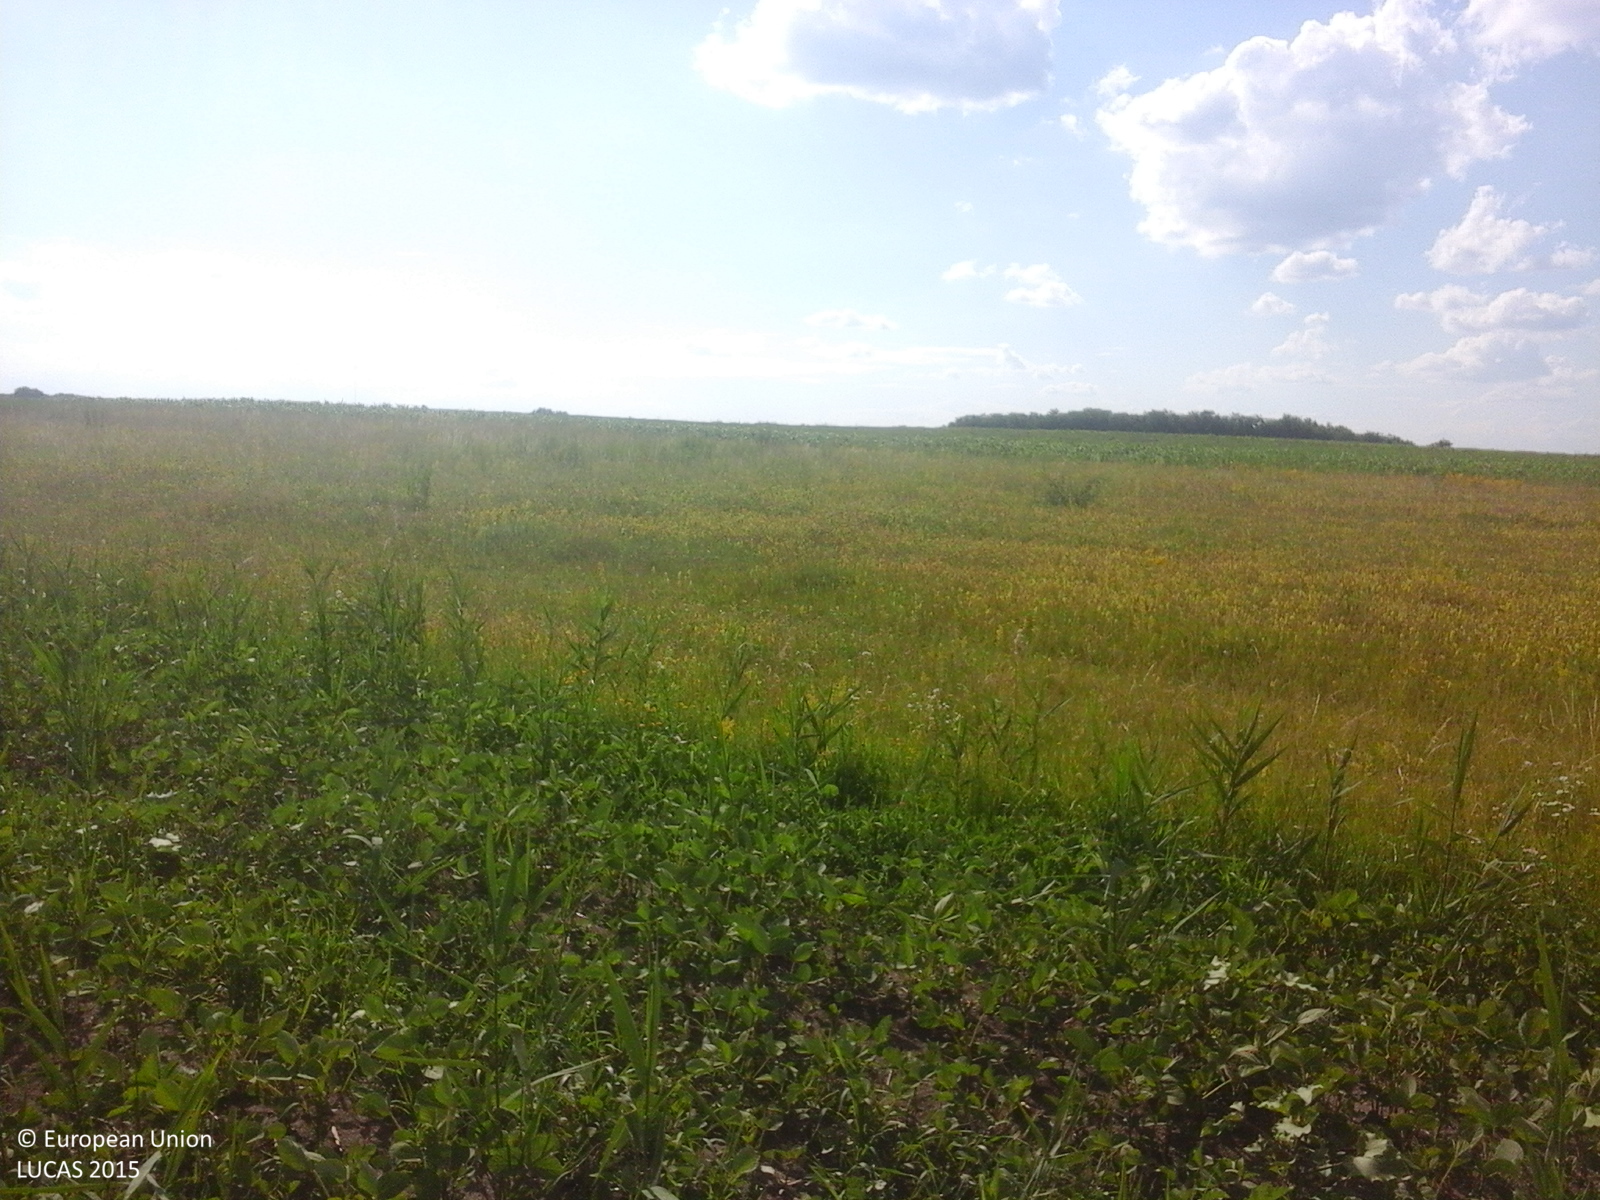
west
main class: Cropland
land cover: Soya
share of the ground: > 75 %
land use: Agriculture (excluding fallow land and kitchen gardens)
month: June
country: RO
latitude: 48.2069
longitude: 26.6903
